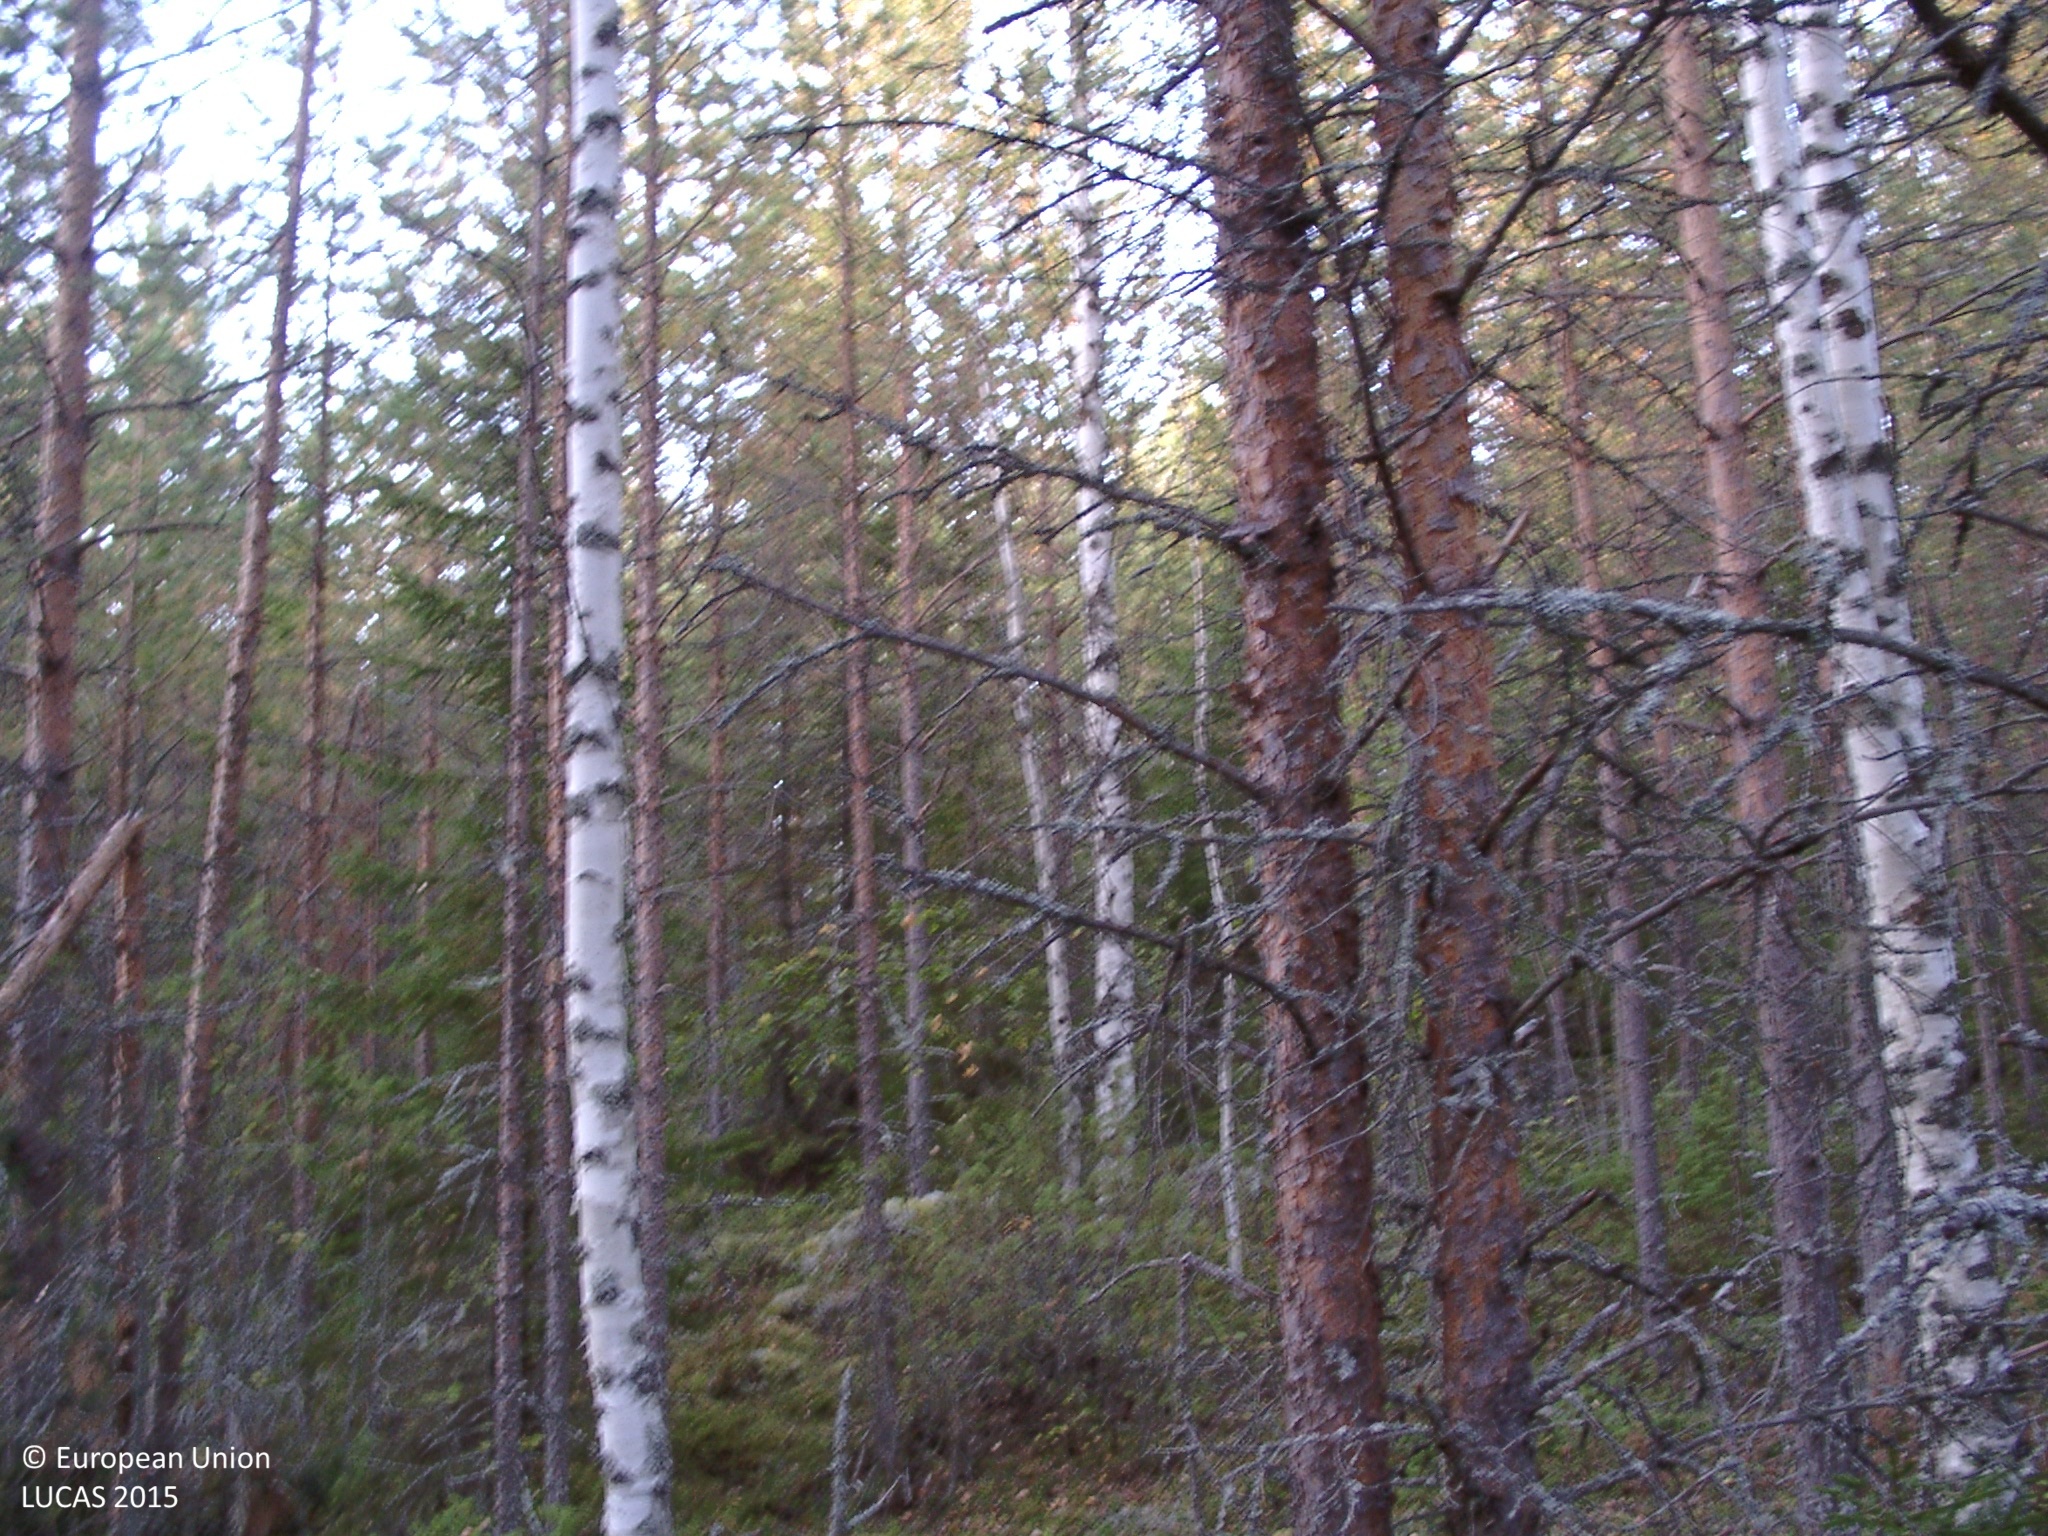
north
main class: Woodland
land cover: Pine dominated coniferous woodland
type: boreal forest
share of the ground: 50 - 75 %
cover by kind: coniferous forest trees 55 %, lichens and mosses 25 %, broadleaved forest trees 10 %, shrubs 10 %
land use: Forestry
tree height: > 5 m
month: September
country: FI
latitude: 62.4382
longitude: 25.5932
